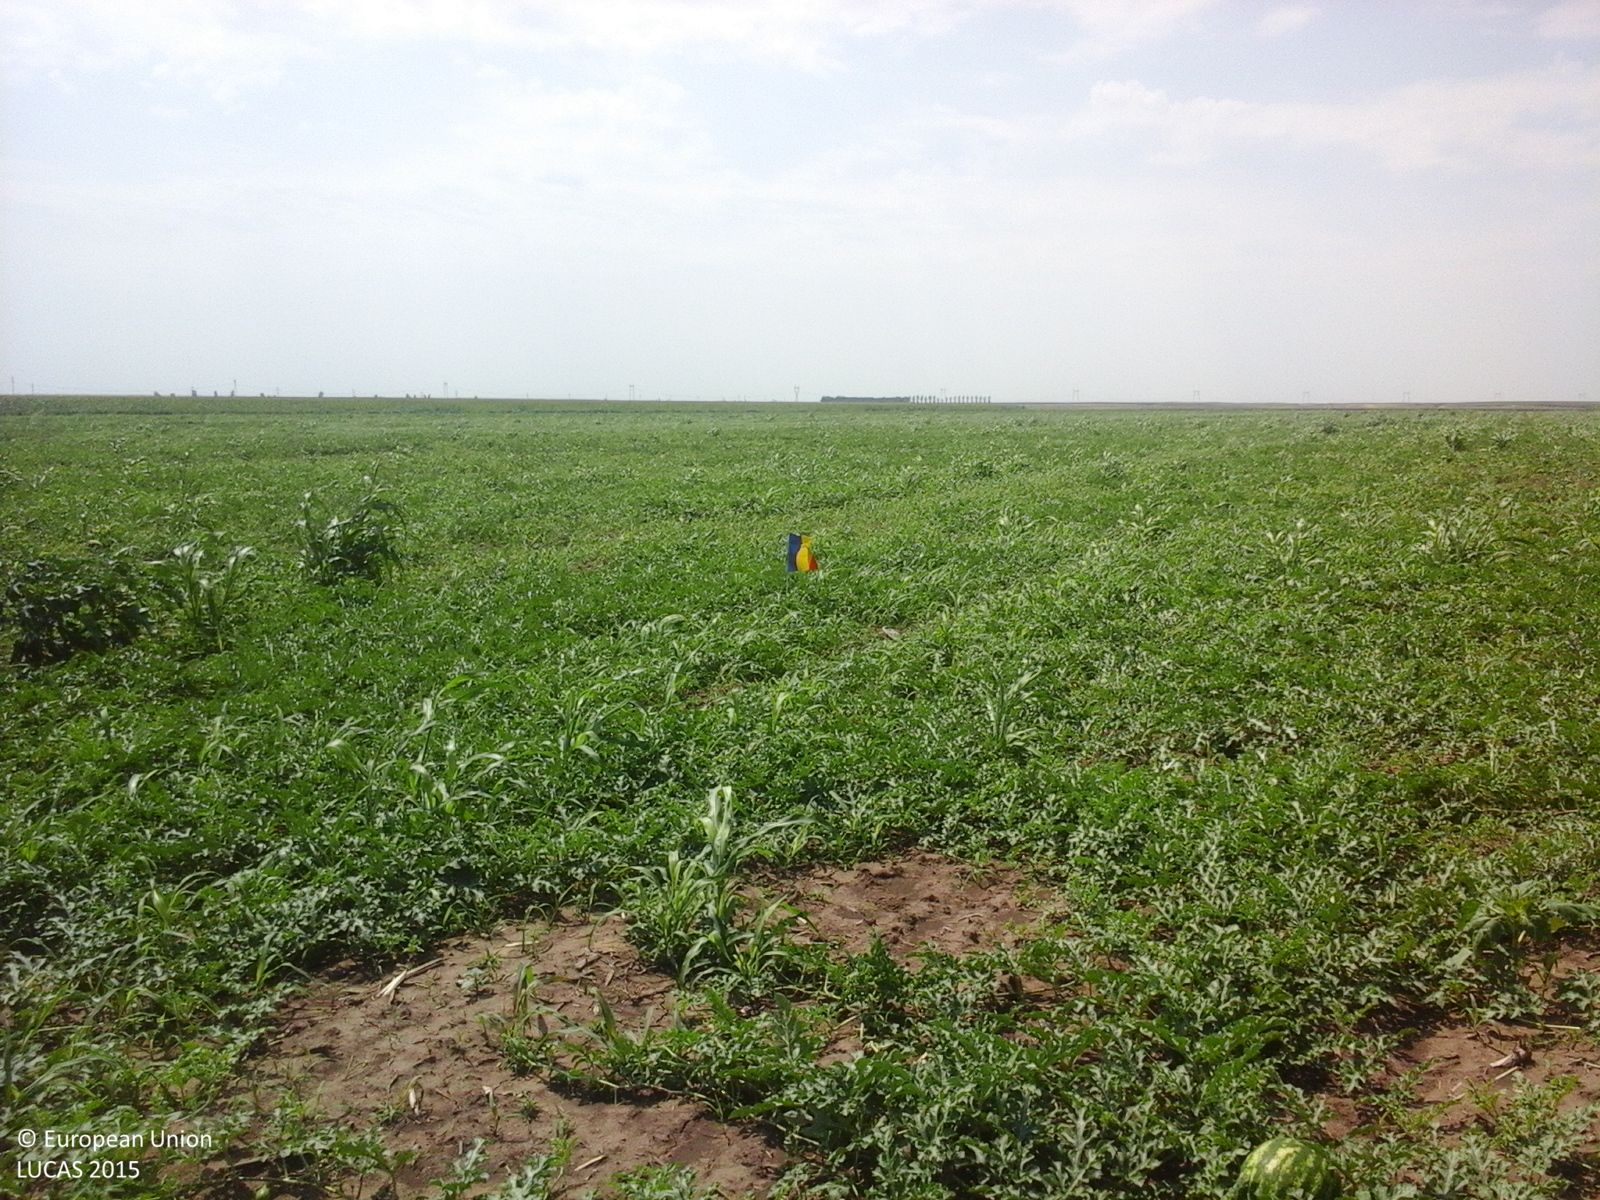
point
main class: Cropland
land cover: Other fresh vegetables
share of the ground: > 75 %
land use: Agriculture (excluding fallow land and kitchen gardens)
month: July
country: RO
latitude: 44.6412
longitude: 27.1417
